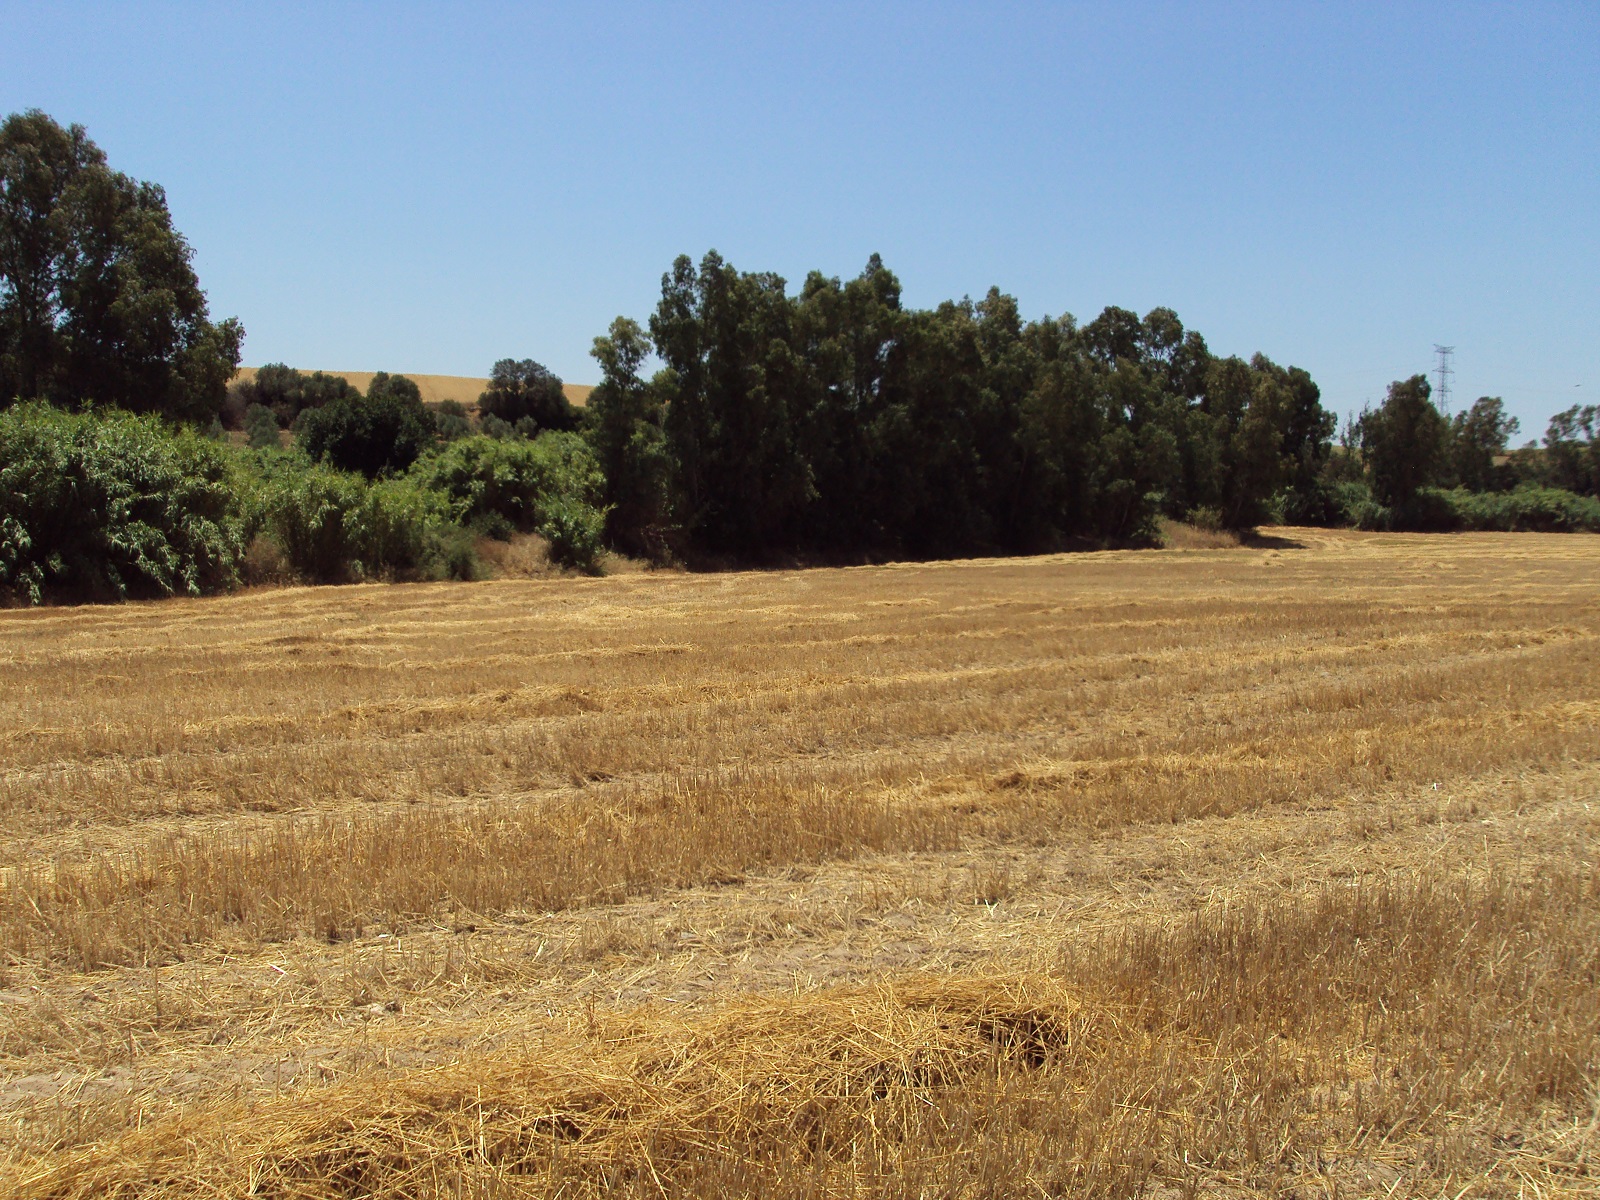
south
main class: Cropland
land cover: Durum wheat
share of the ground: > 75 %
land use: Agriculture (excluding fallow land and kitchen gardens)
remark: Harvested field
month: June
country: ES
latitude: 37.3727
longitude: -6.8761
